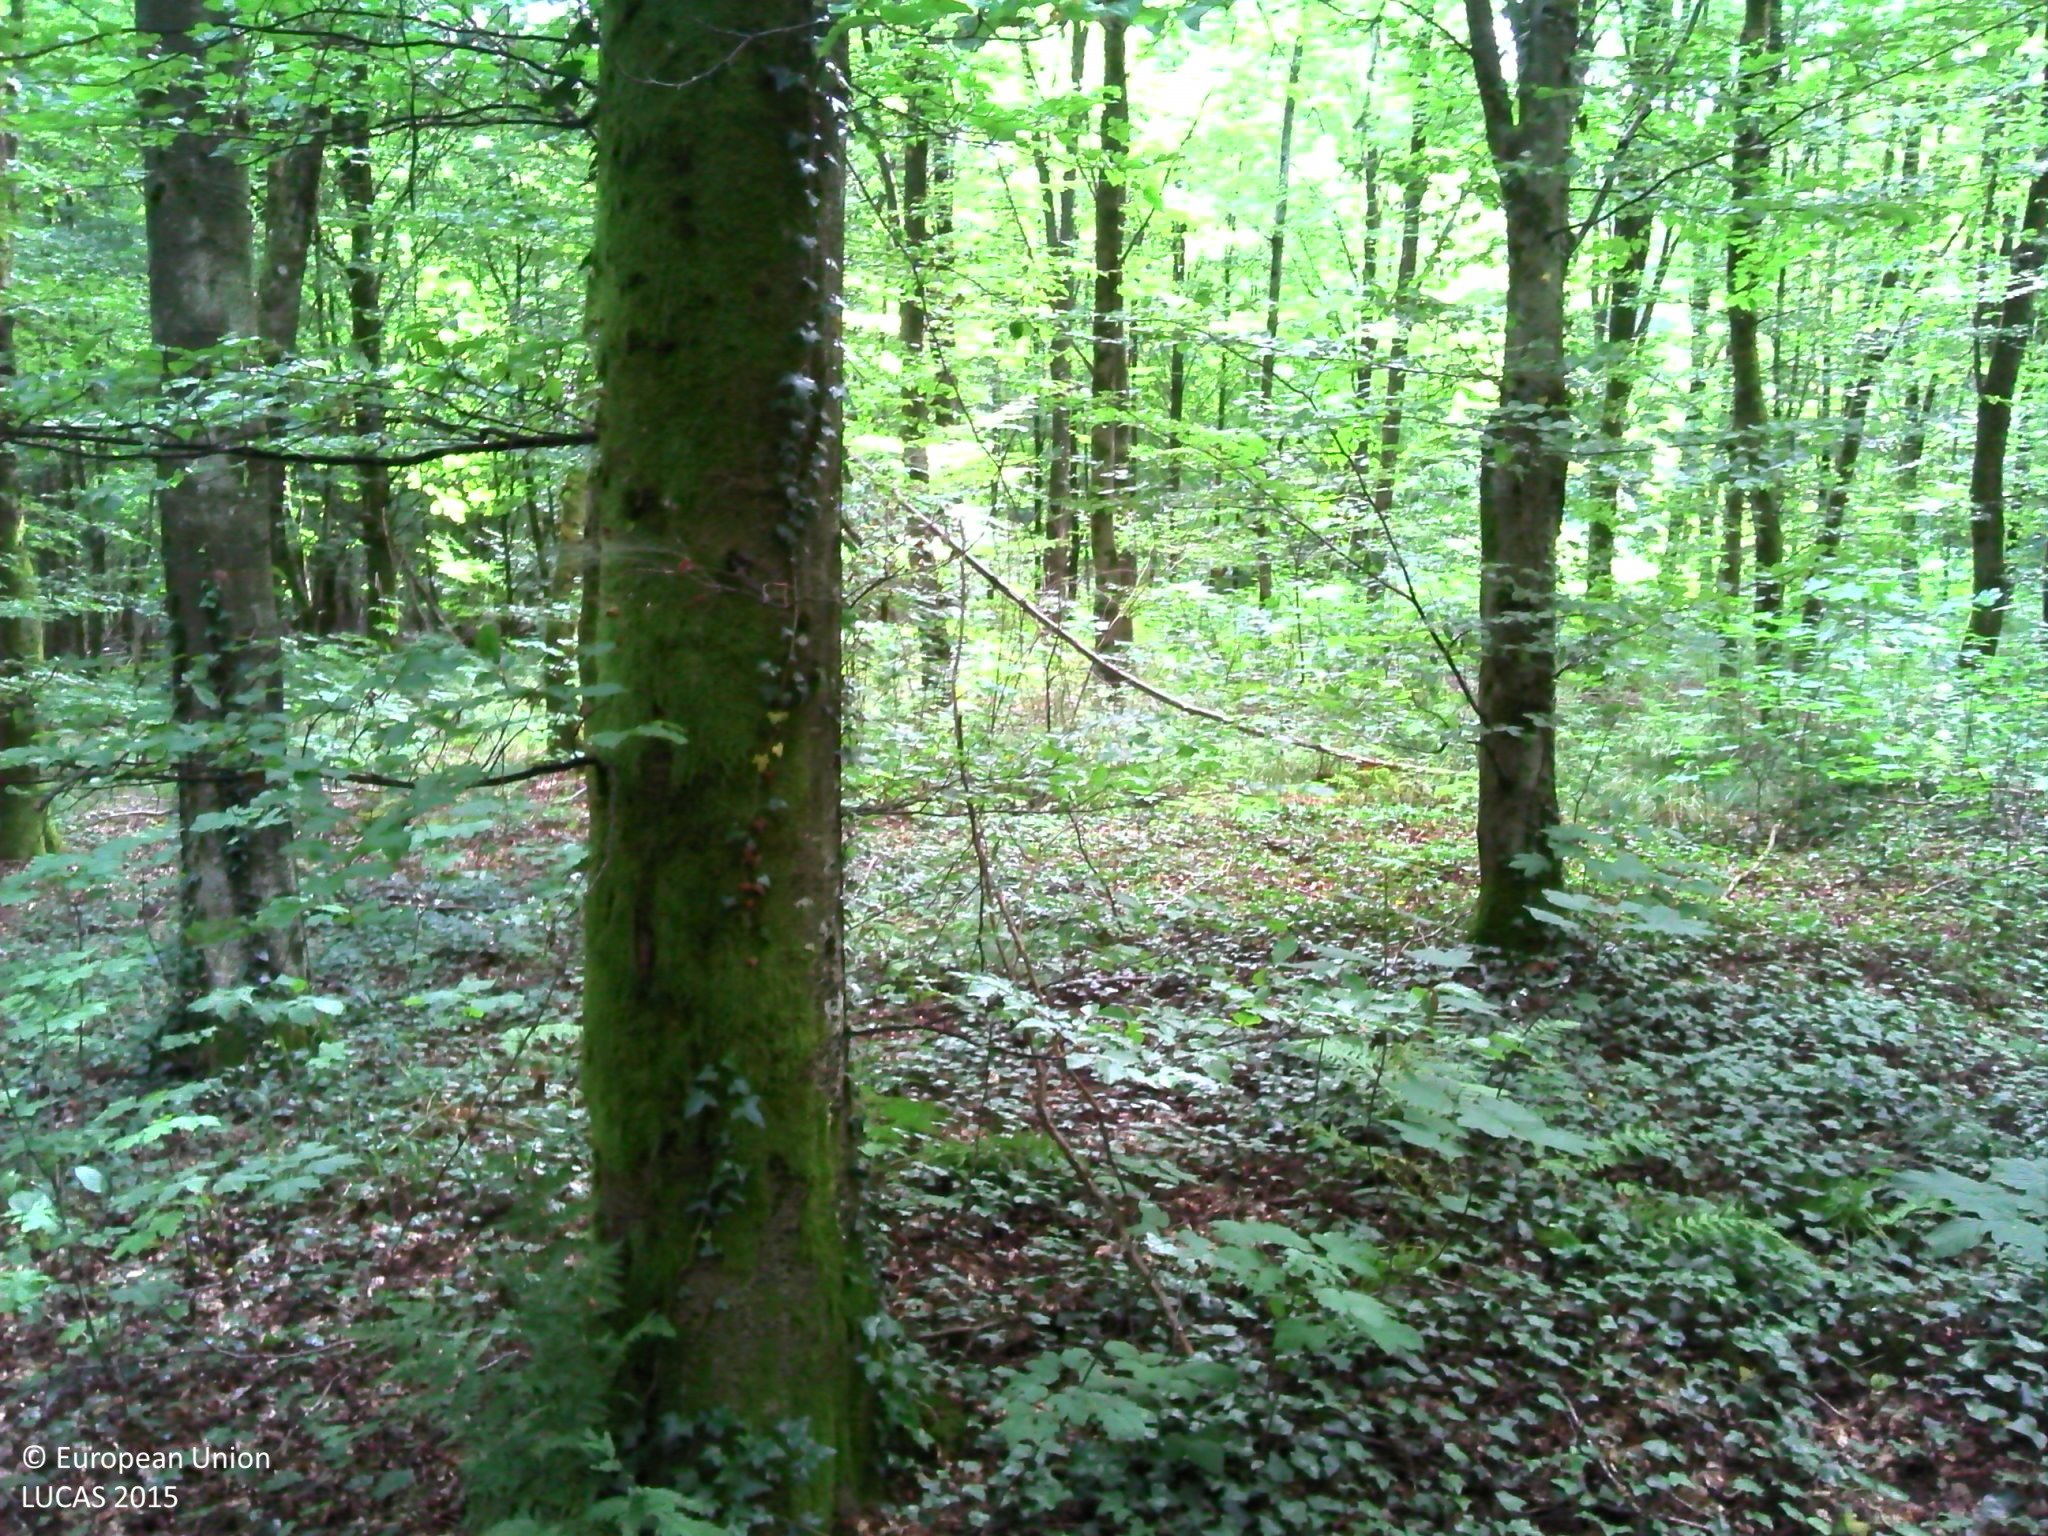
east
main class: Woodland
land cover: Broadleaved woodland
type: beech forest
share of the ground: > 75 %
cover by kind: broadleaved forest trees 95 %, herbaceous plants 5 %
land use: Forestry
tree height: > 5 m
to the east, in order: Broadleaved woodland; Tracks; Broadleaved woodland; Fences; Barley; Electric lines; Grass margins; Fences; Grassland without tree/shrub cover; Fences; Grassland without tree/shrub cover; Fences; Spontaneously vegetated surfaces
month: July
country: BE
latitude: 49.6125
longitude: 5.5837
